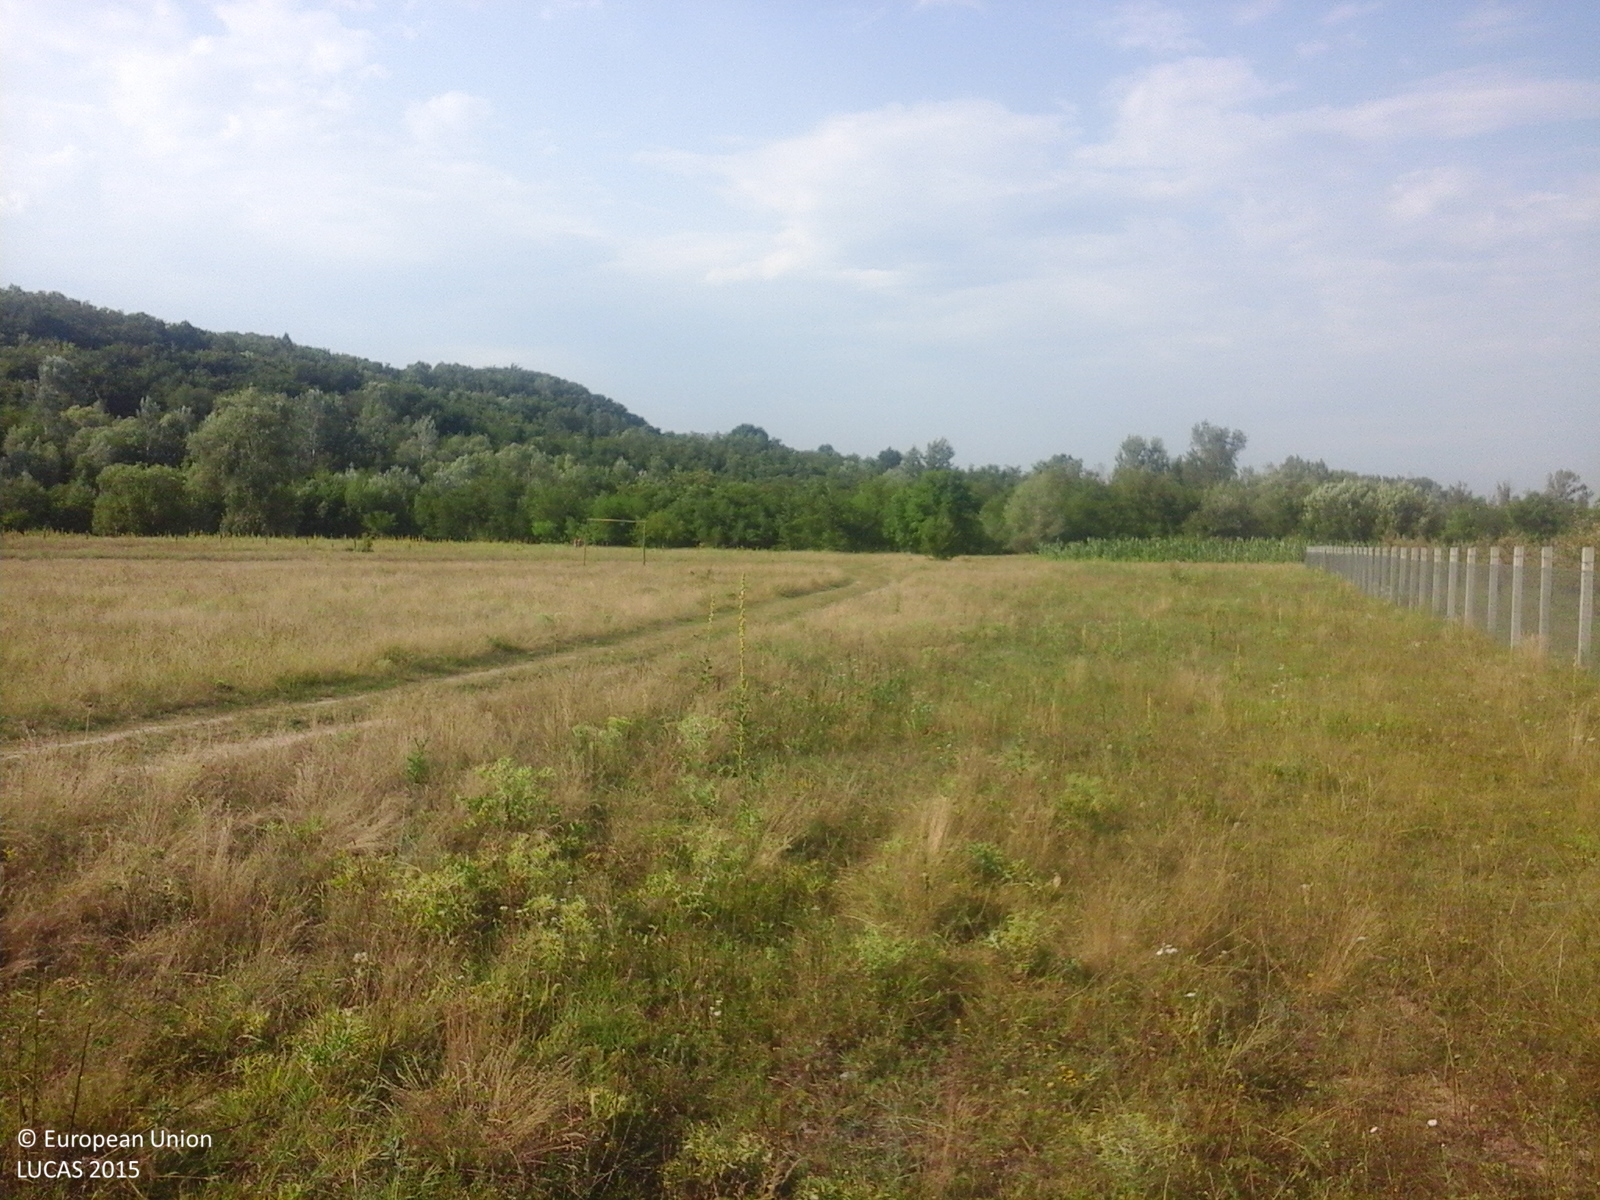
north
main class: Cropland
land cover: Apple fruit
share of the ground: > 75 %
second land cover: Spontaneously vegetated surfaces
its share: > 75 %
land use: Agriculture (excluding fallow land and kitchen gardens)
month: July
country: RO
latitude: 45.0442
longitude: 24.5109
